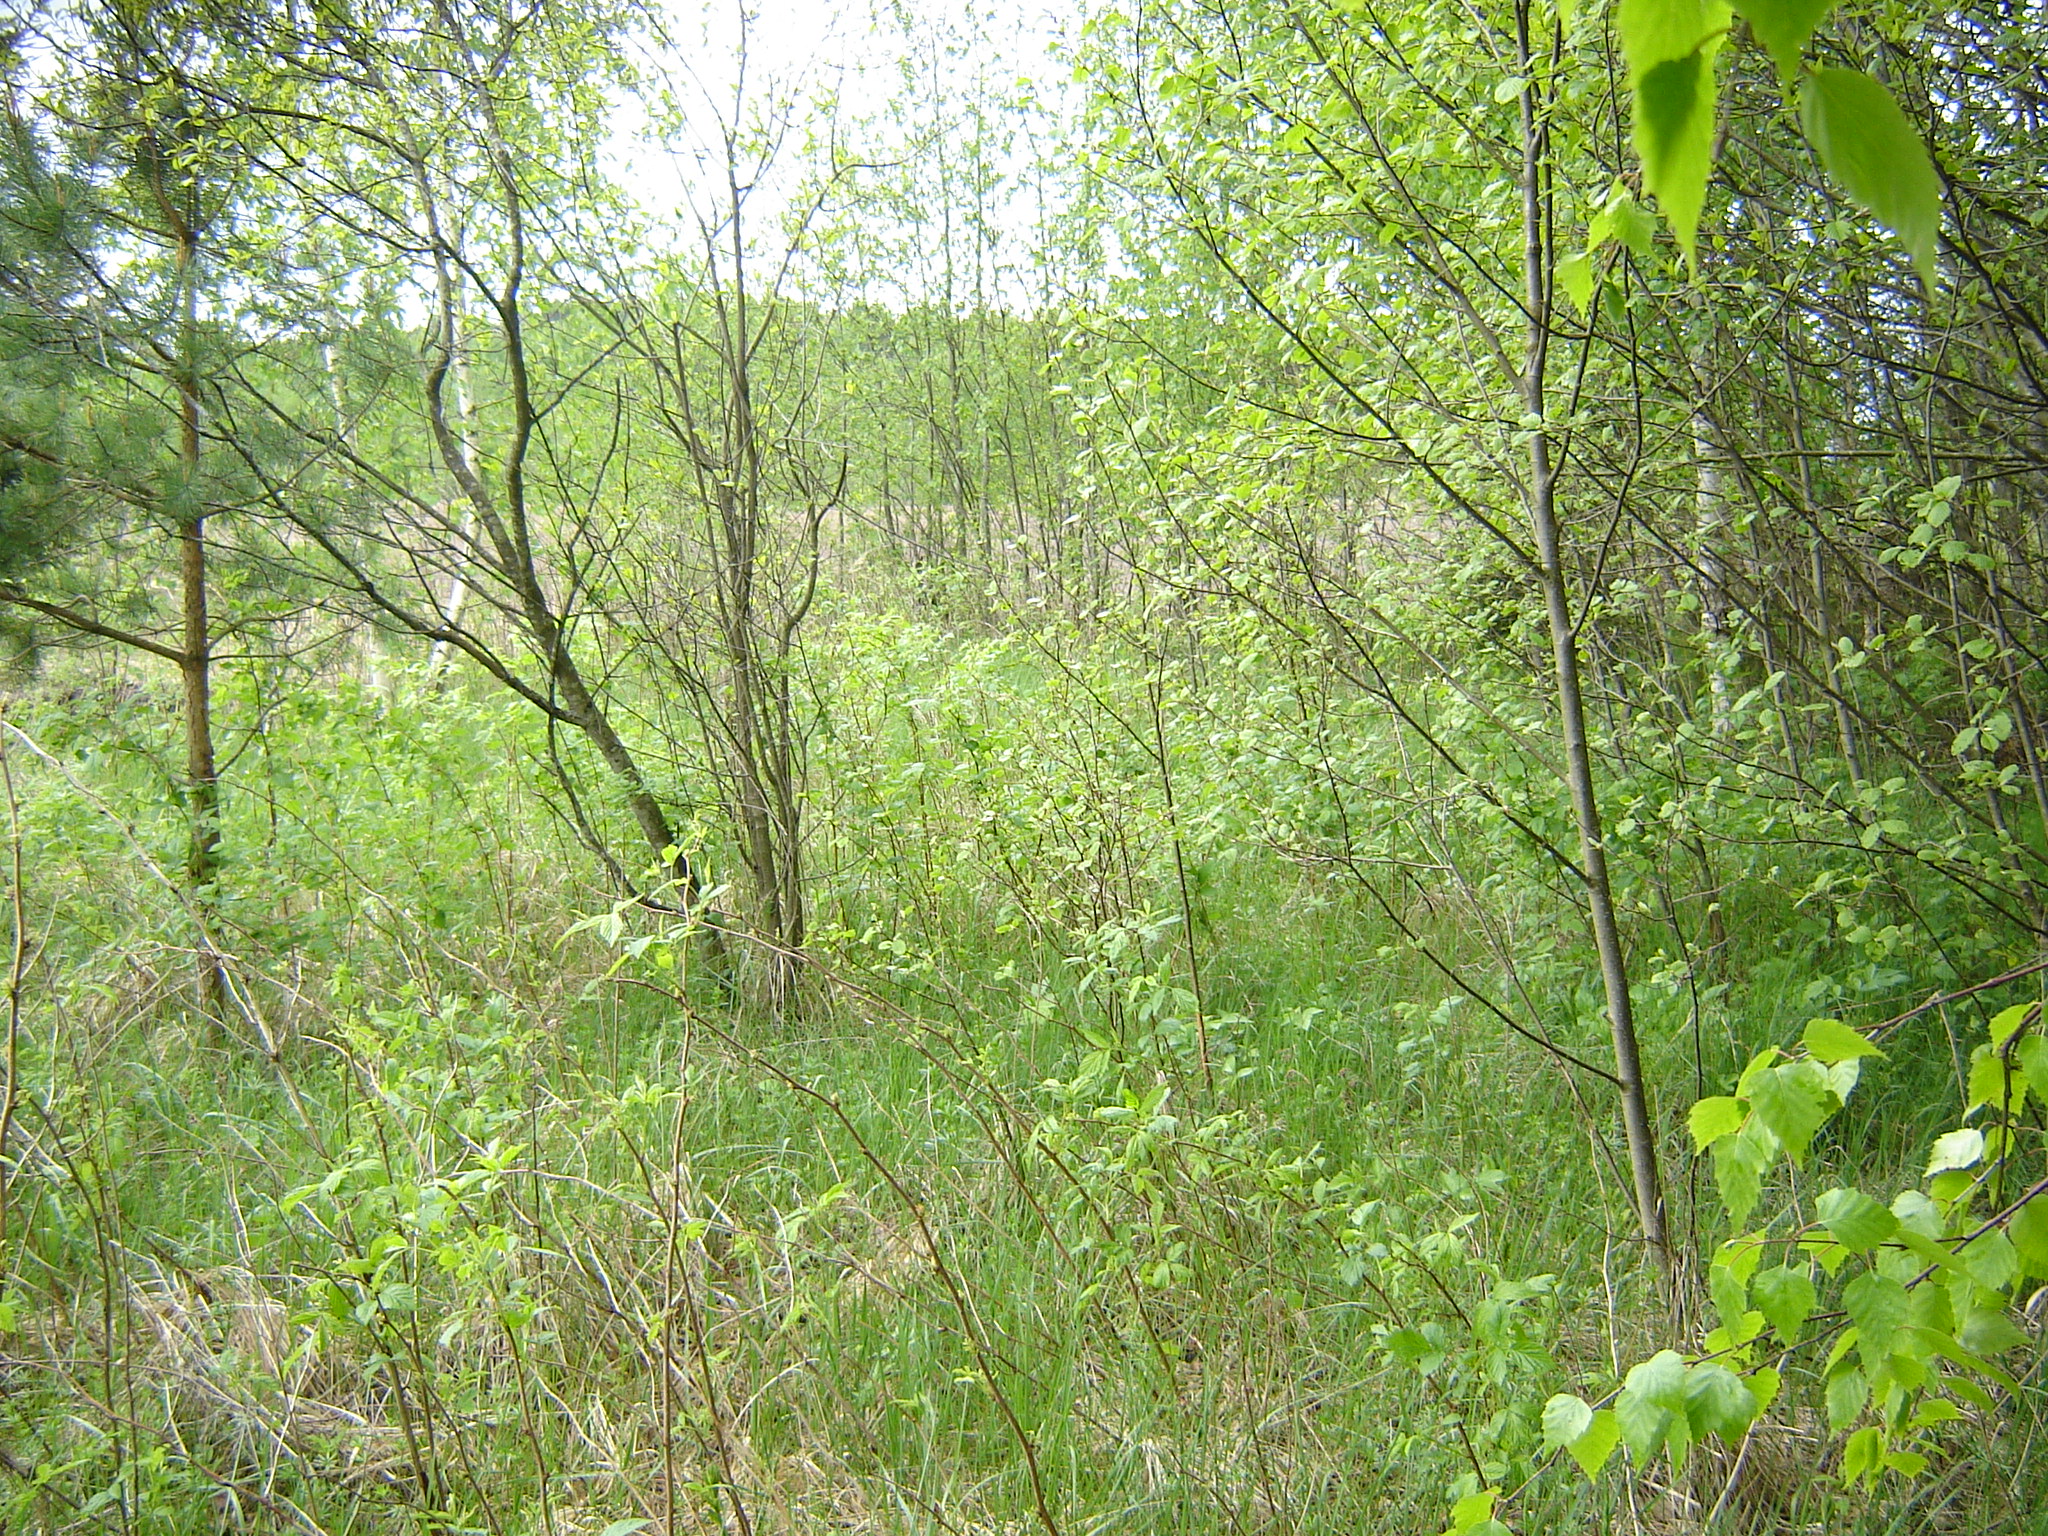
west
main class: Woodland
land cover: Broadleaved woodland
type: non-riverine alder, birch or aspen forest
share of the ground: > 75 %
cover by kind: broadleaved forest trees 80 %, herbaceous plants 10 %, coniferous forest trees 5 %, shrubs 5 %
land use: Forestry
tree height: > 5 m
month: May
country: LT
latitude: 56.1008
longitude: 25.3425
